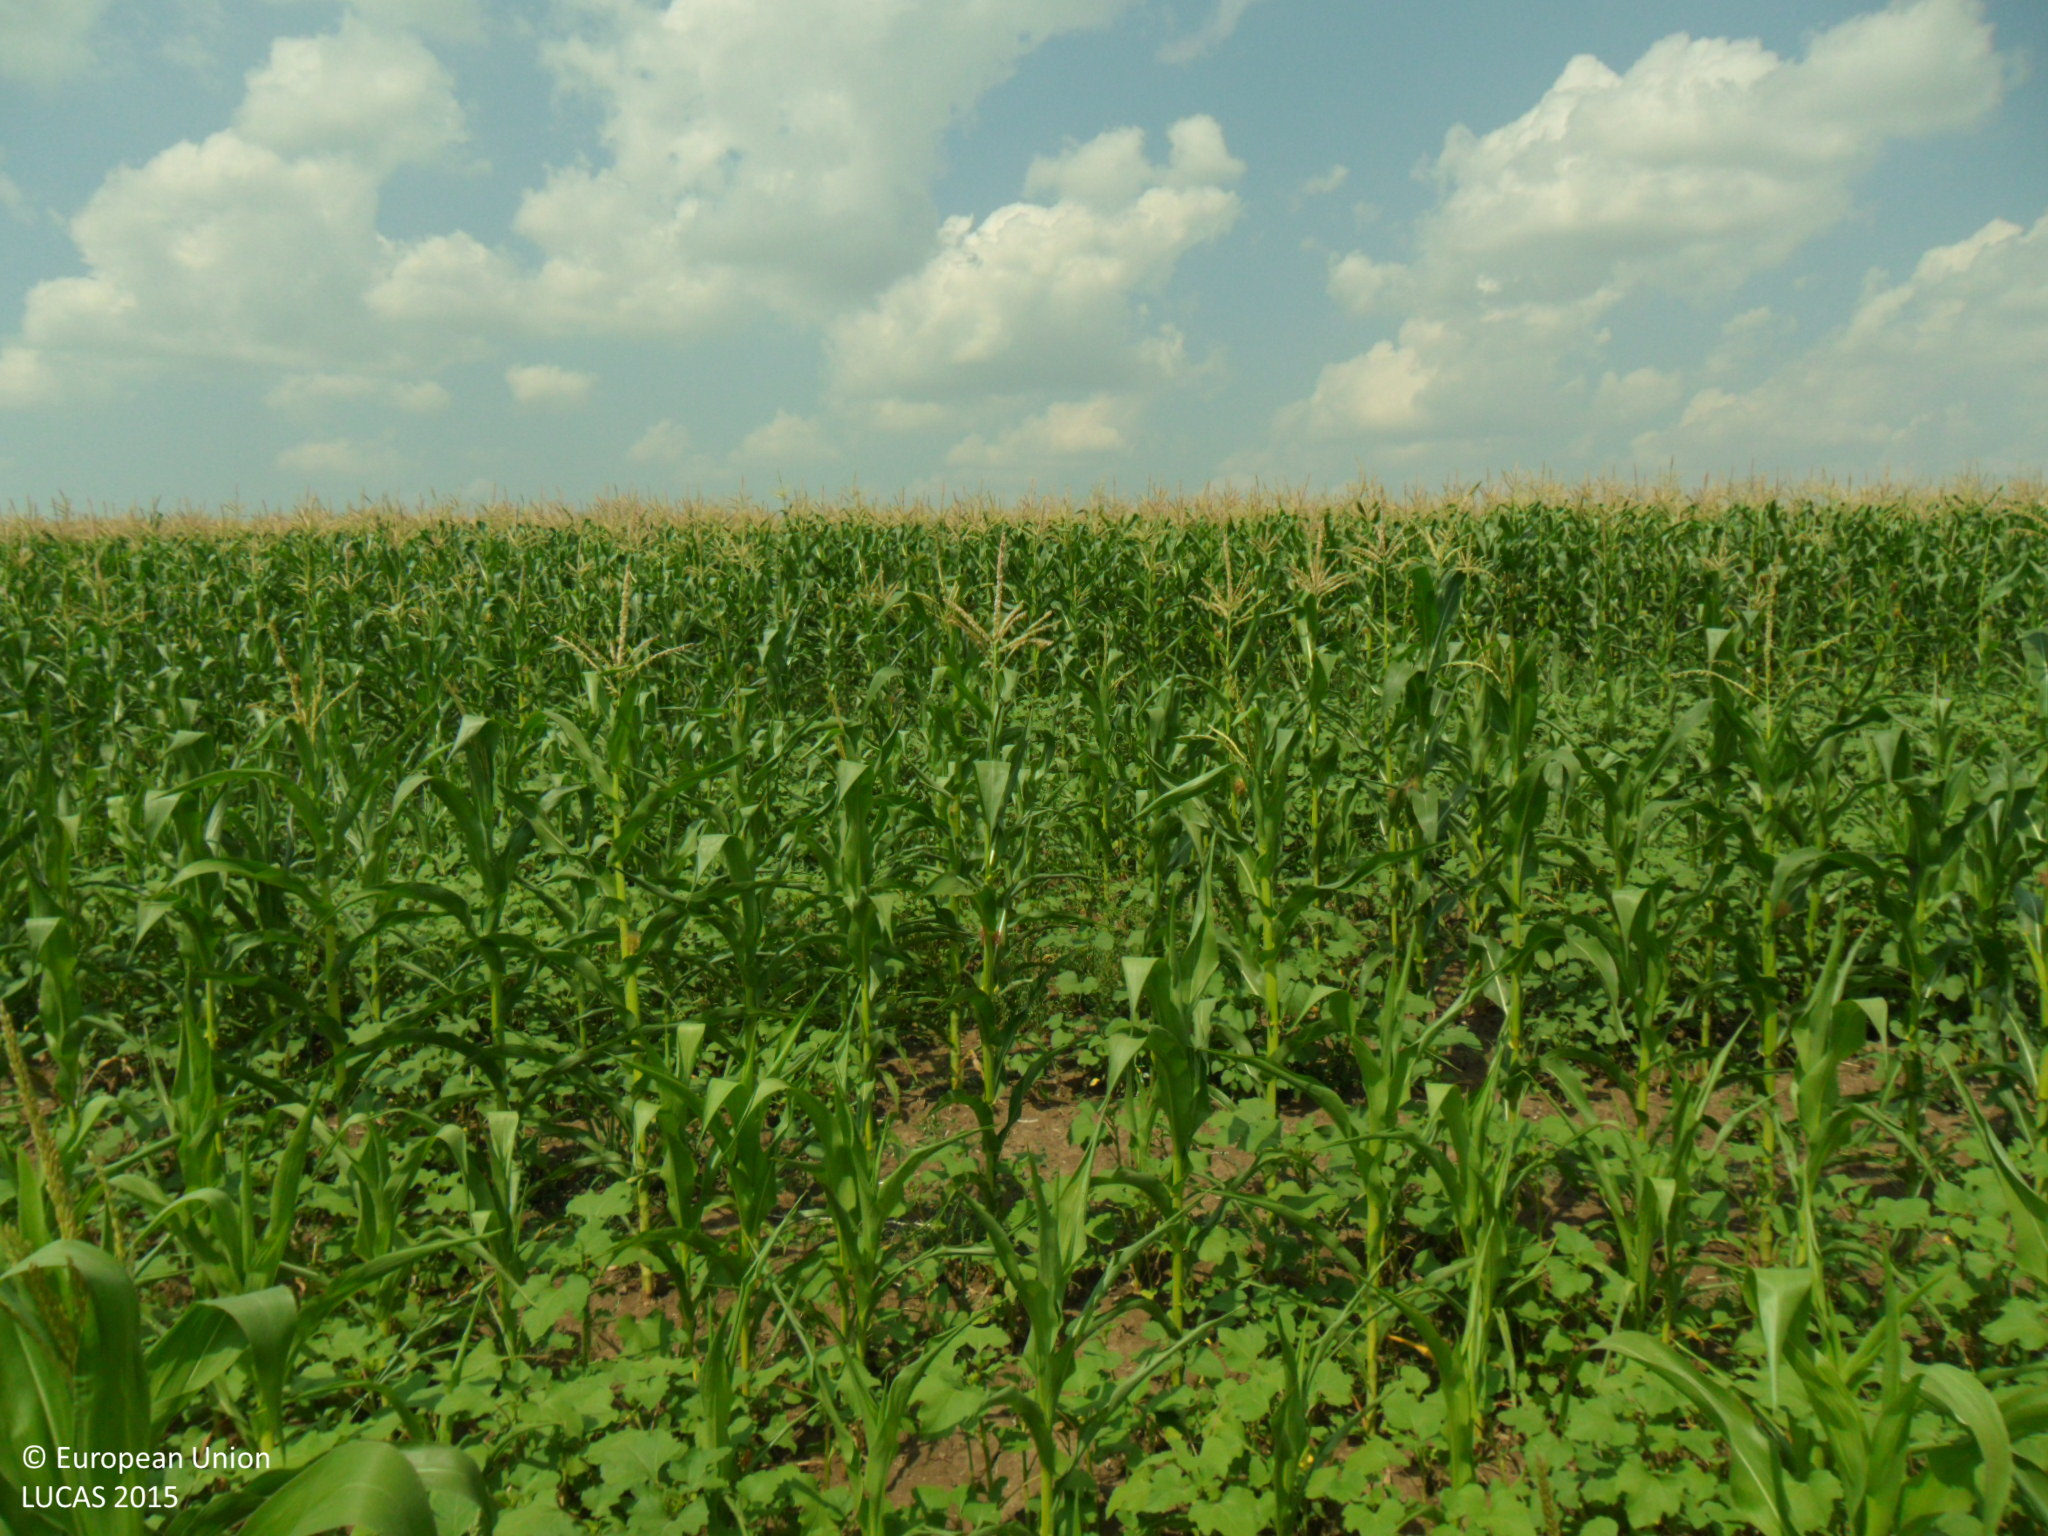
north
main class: Cropland
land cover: Sunflower
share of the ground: > 75 %
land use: Agriculture (excluding fallow land and kitchen gardens)
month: July
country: BG
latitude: 43.5973
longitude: 27.0026
